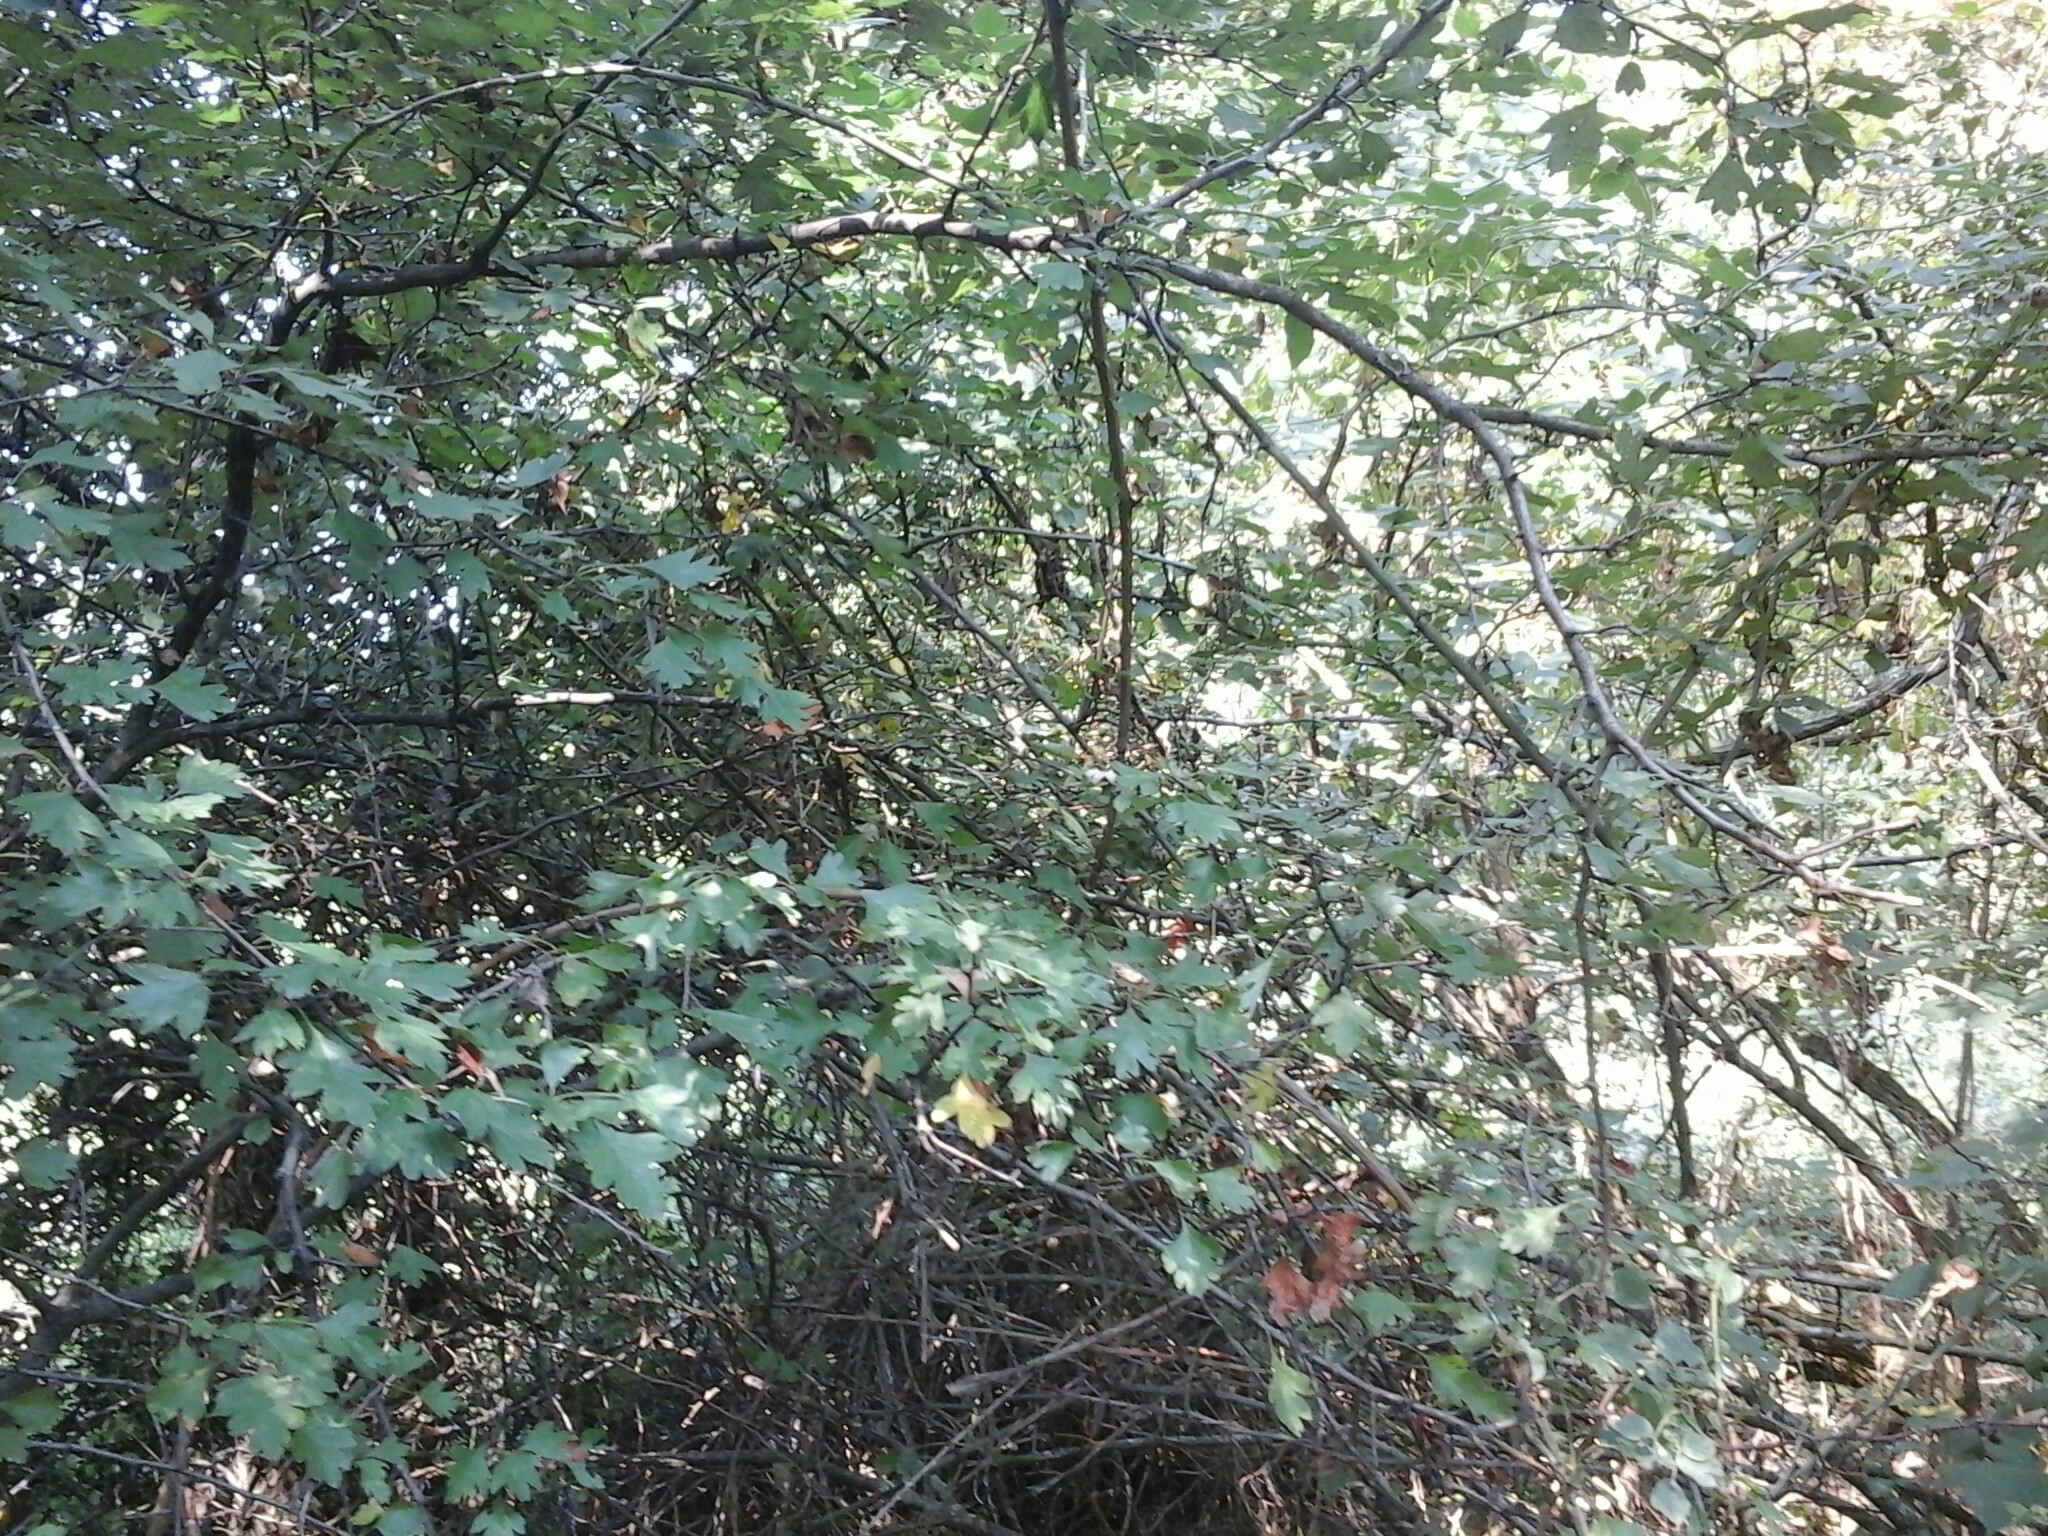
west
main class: Woodland
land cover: Broadleaved woodland
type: mesophytic deciduous forest
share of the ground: > 75 %
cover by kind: broadleaved forest trees 95 %, herbaceous plants 5 %
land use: Forestry
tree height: > 5 m
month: August
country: HU
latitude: 47.3978
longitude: 17.8933
